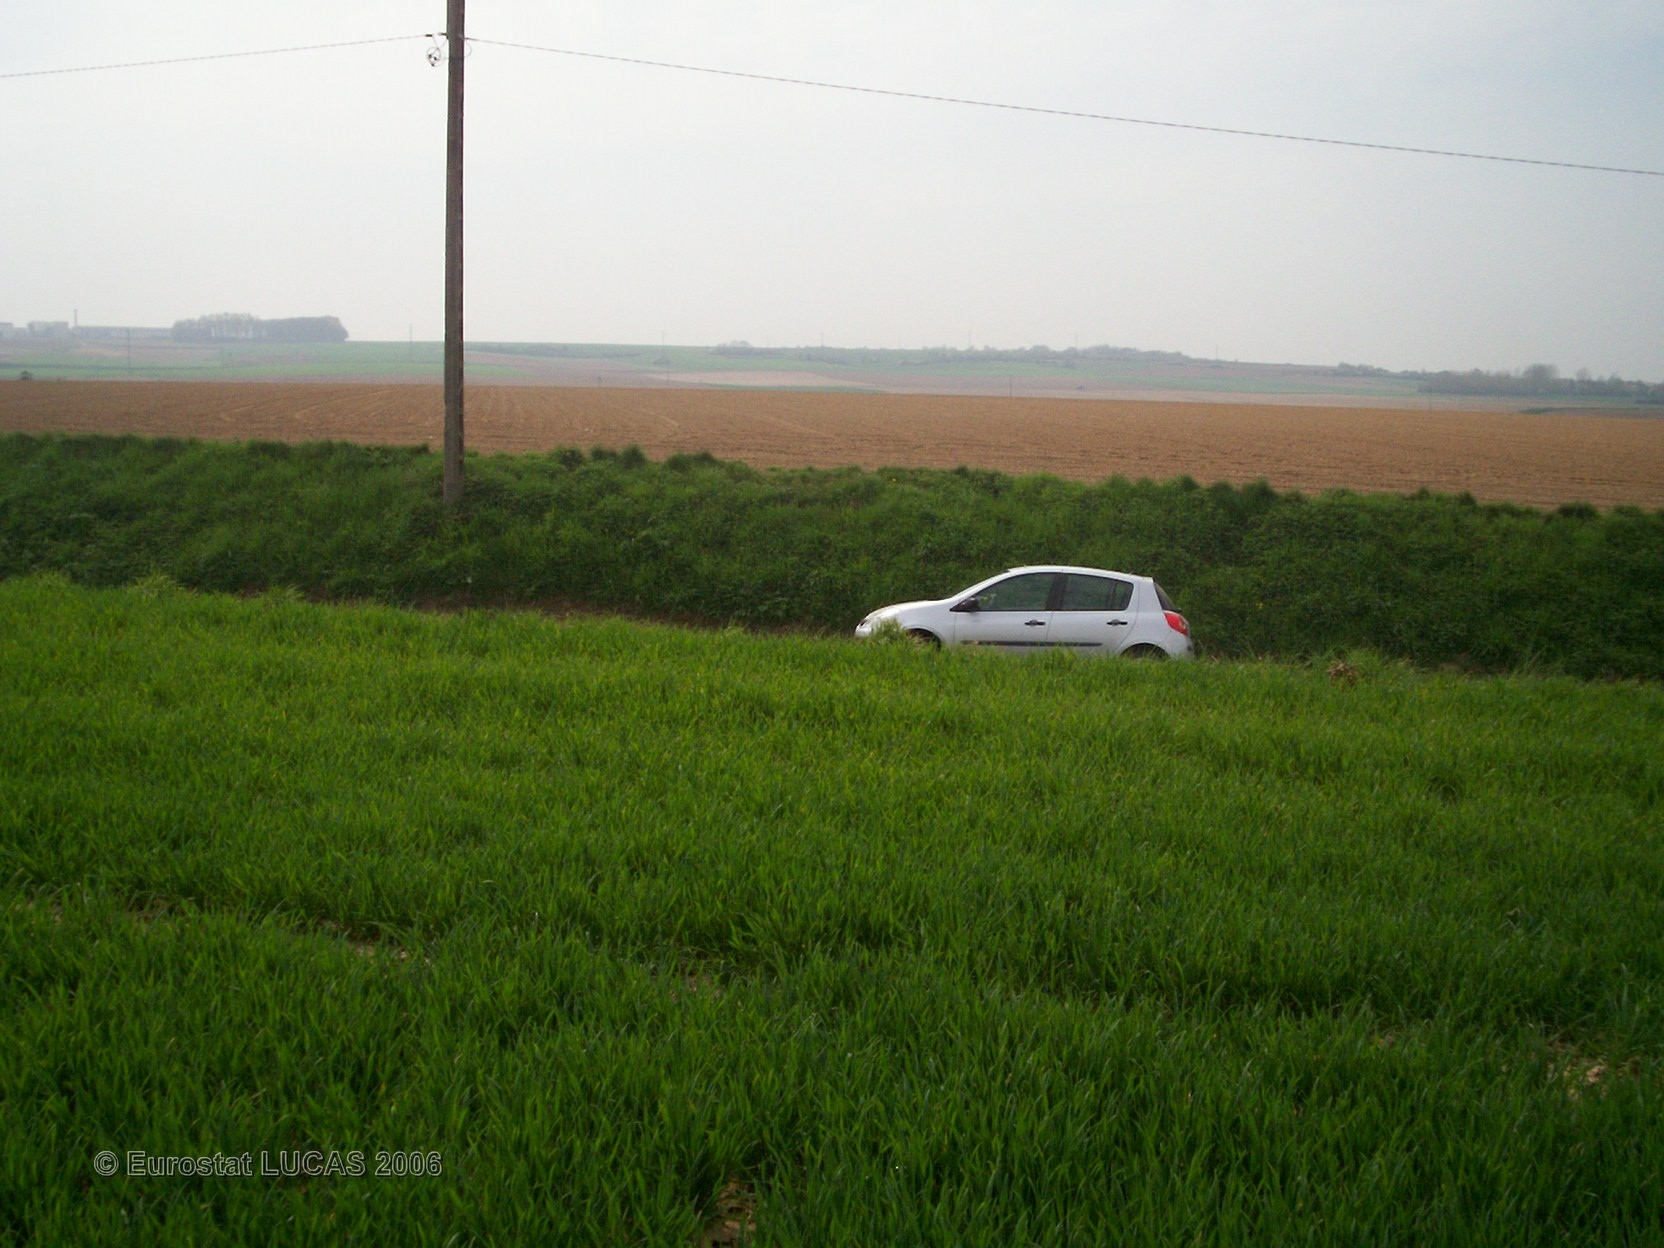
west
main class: Cropland
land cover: Common wheat
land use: Agriculture (excluding fallow land and kitchen gardens)
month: April
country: FR
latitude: 50.5328
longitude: 2.4959
